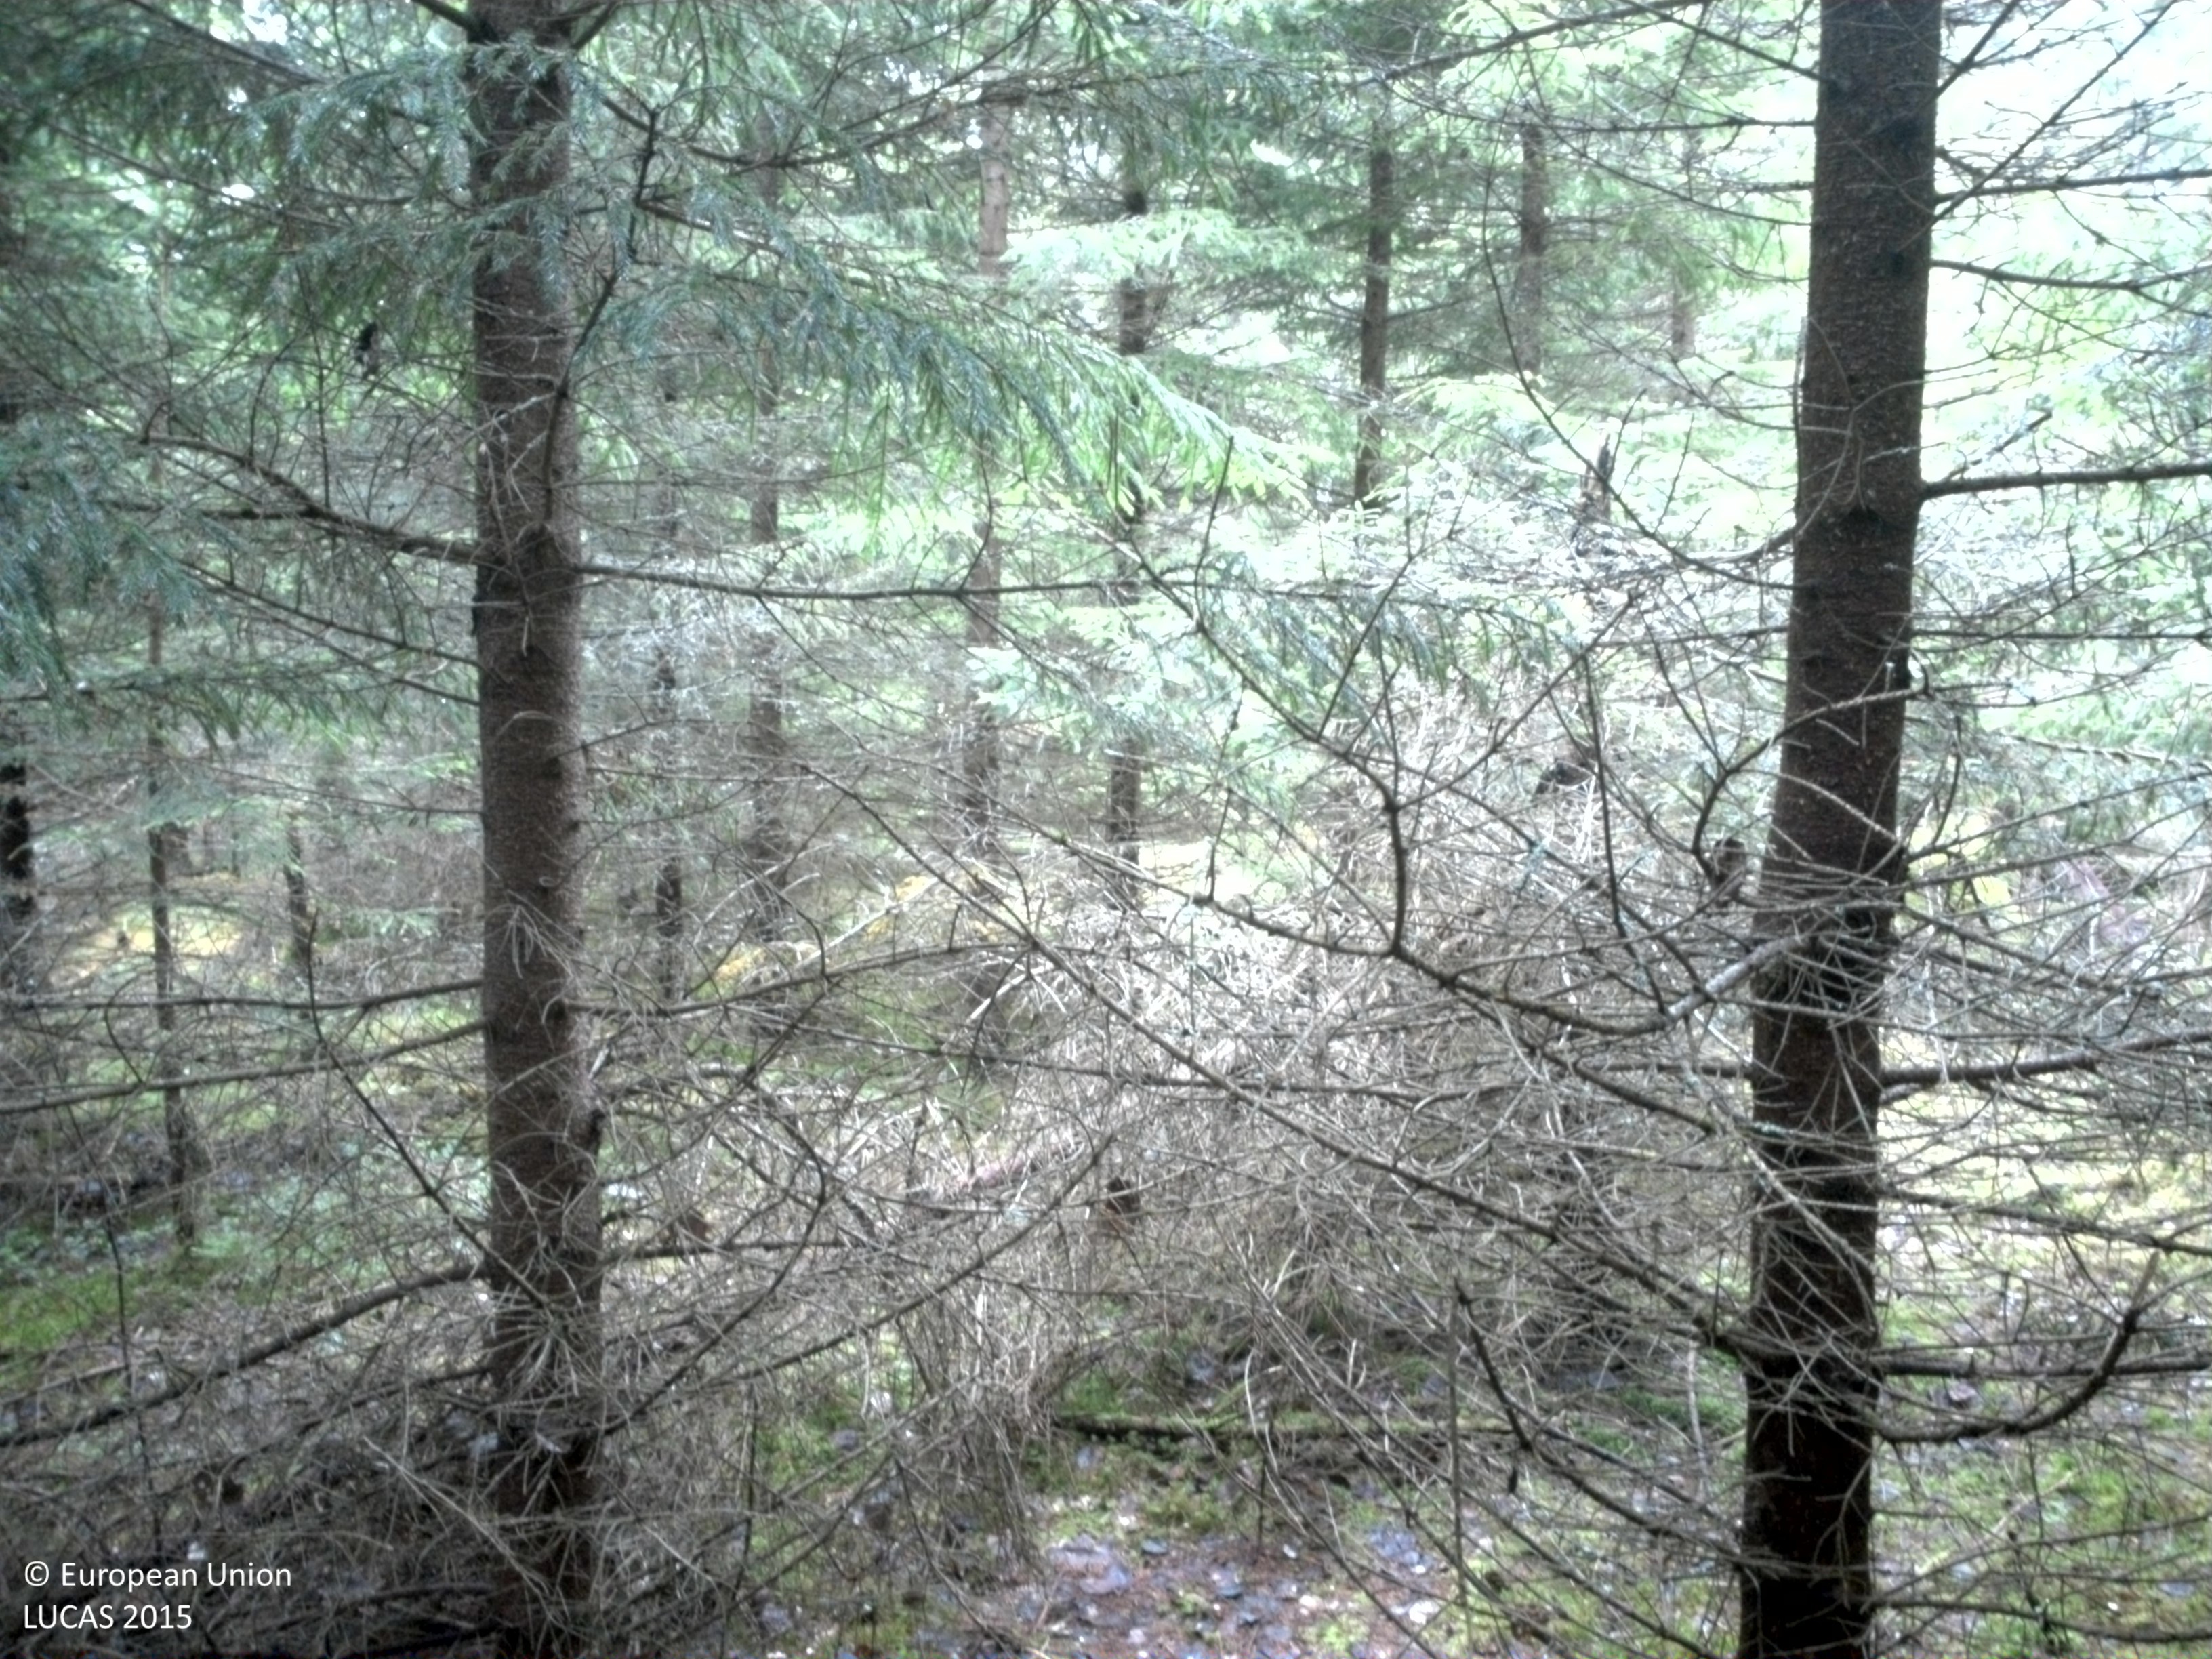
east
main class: Woodland
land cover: Spruce dominated coniferous woodland
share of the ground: > 75 %
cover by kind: coniferous forest trees 80 %, broadleaved forest trees 10 %, lichens and mosses 10 %
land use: Forestry
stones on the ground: < 10 %
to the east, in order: Spruce dominated coniferous woodland; Rivers and streams; Spruce dominated coniferous woodland; Tracks; Spruce dominated coniferous woodland; Spruce dominated mixed woodland; Spruce dominated coniferous woodland; Pine dominated coniferous woodland
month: August
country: SE
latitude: 57.8732
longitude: 13.9568
